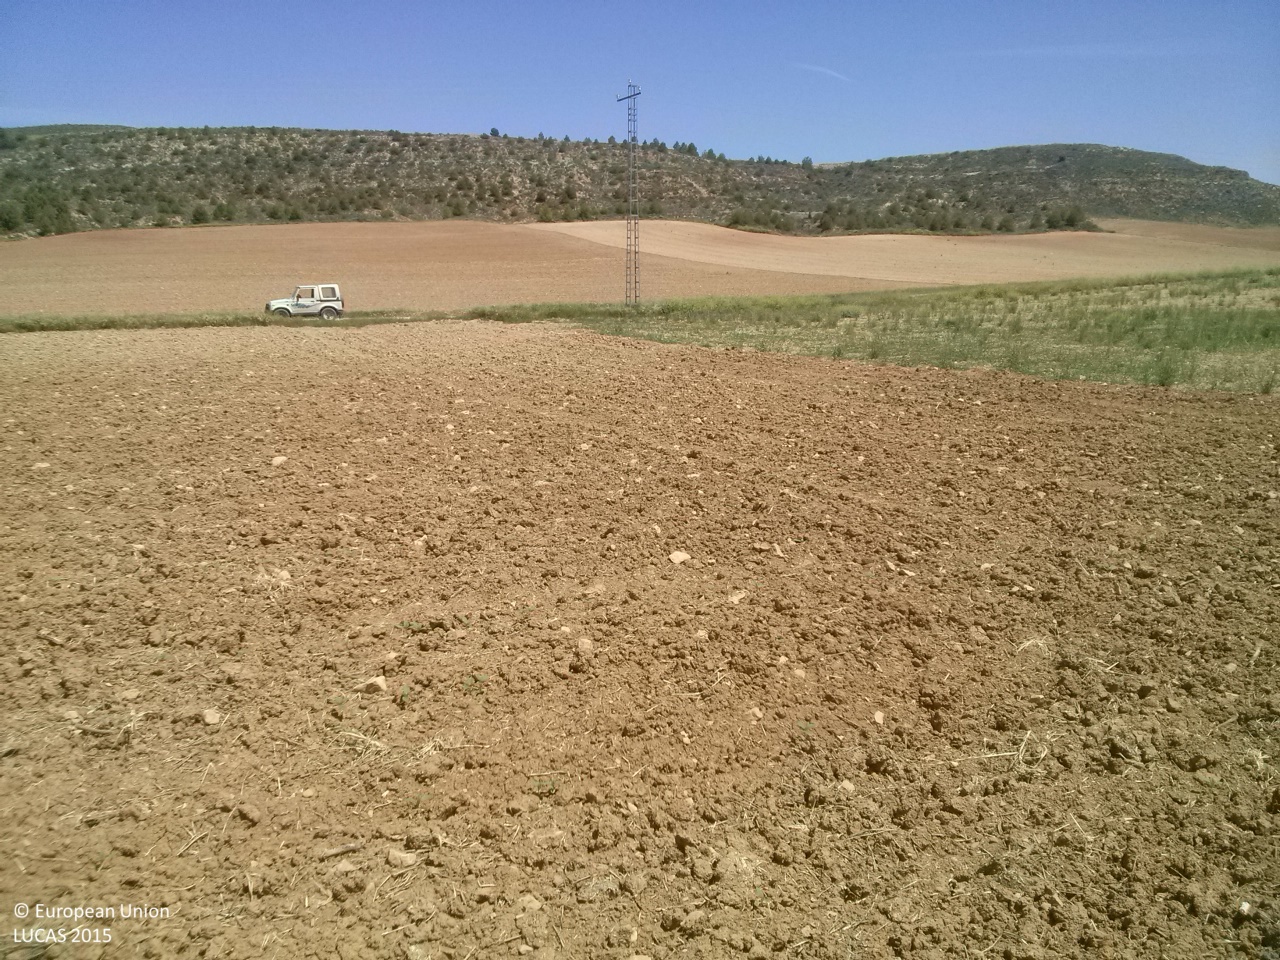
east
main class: Cropland
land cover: Sunflower
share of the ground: < 10 %
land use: Agriculture (excluding fallow land and kitchen gardens)
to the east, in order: Sunflower; Electric lines; Grass margins; Tracks; Grass margins; Sunflower
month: May
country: ES
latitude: 40.0223
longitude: -2.7104
